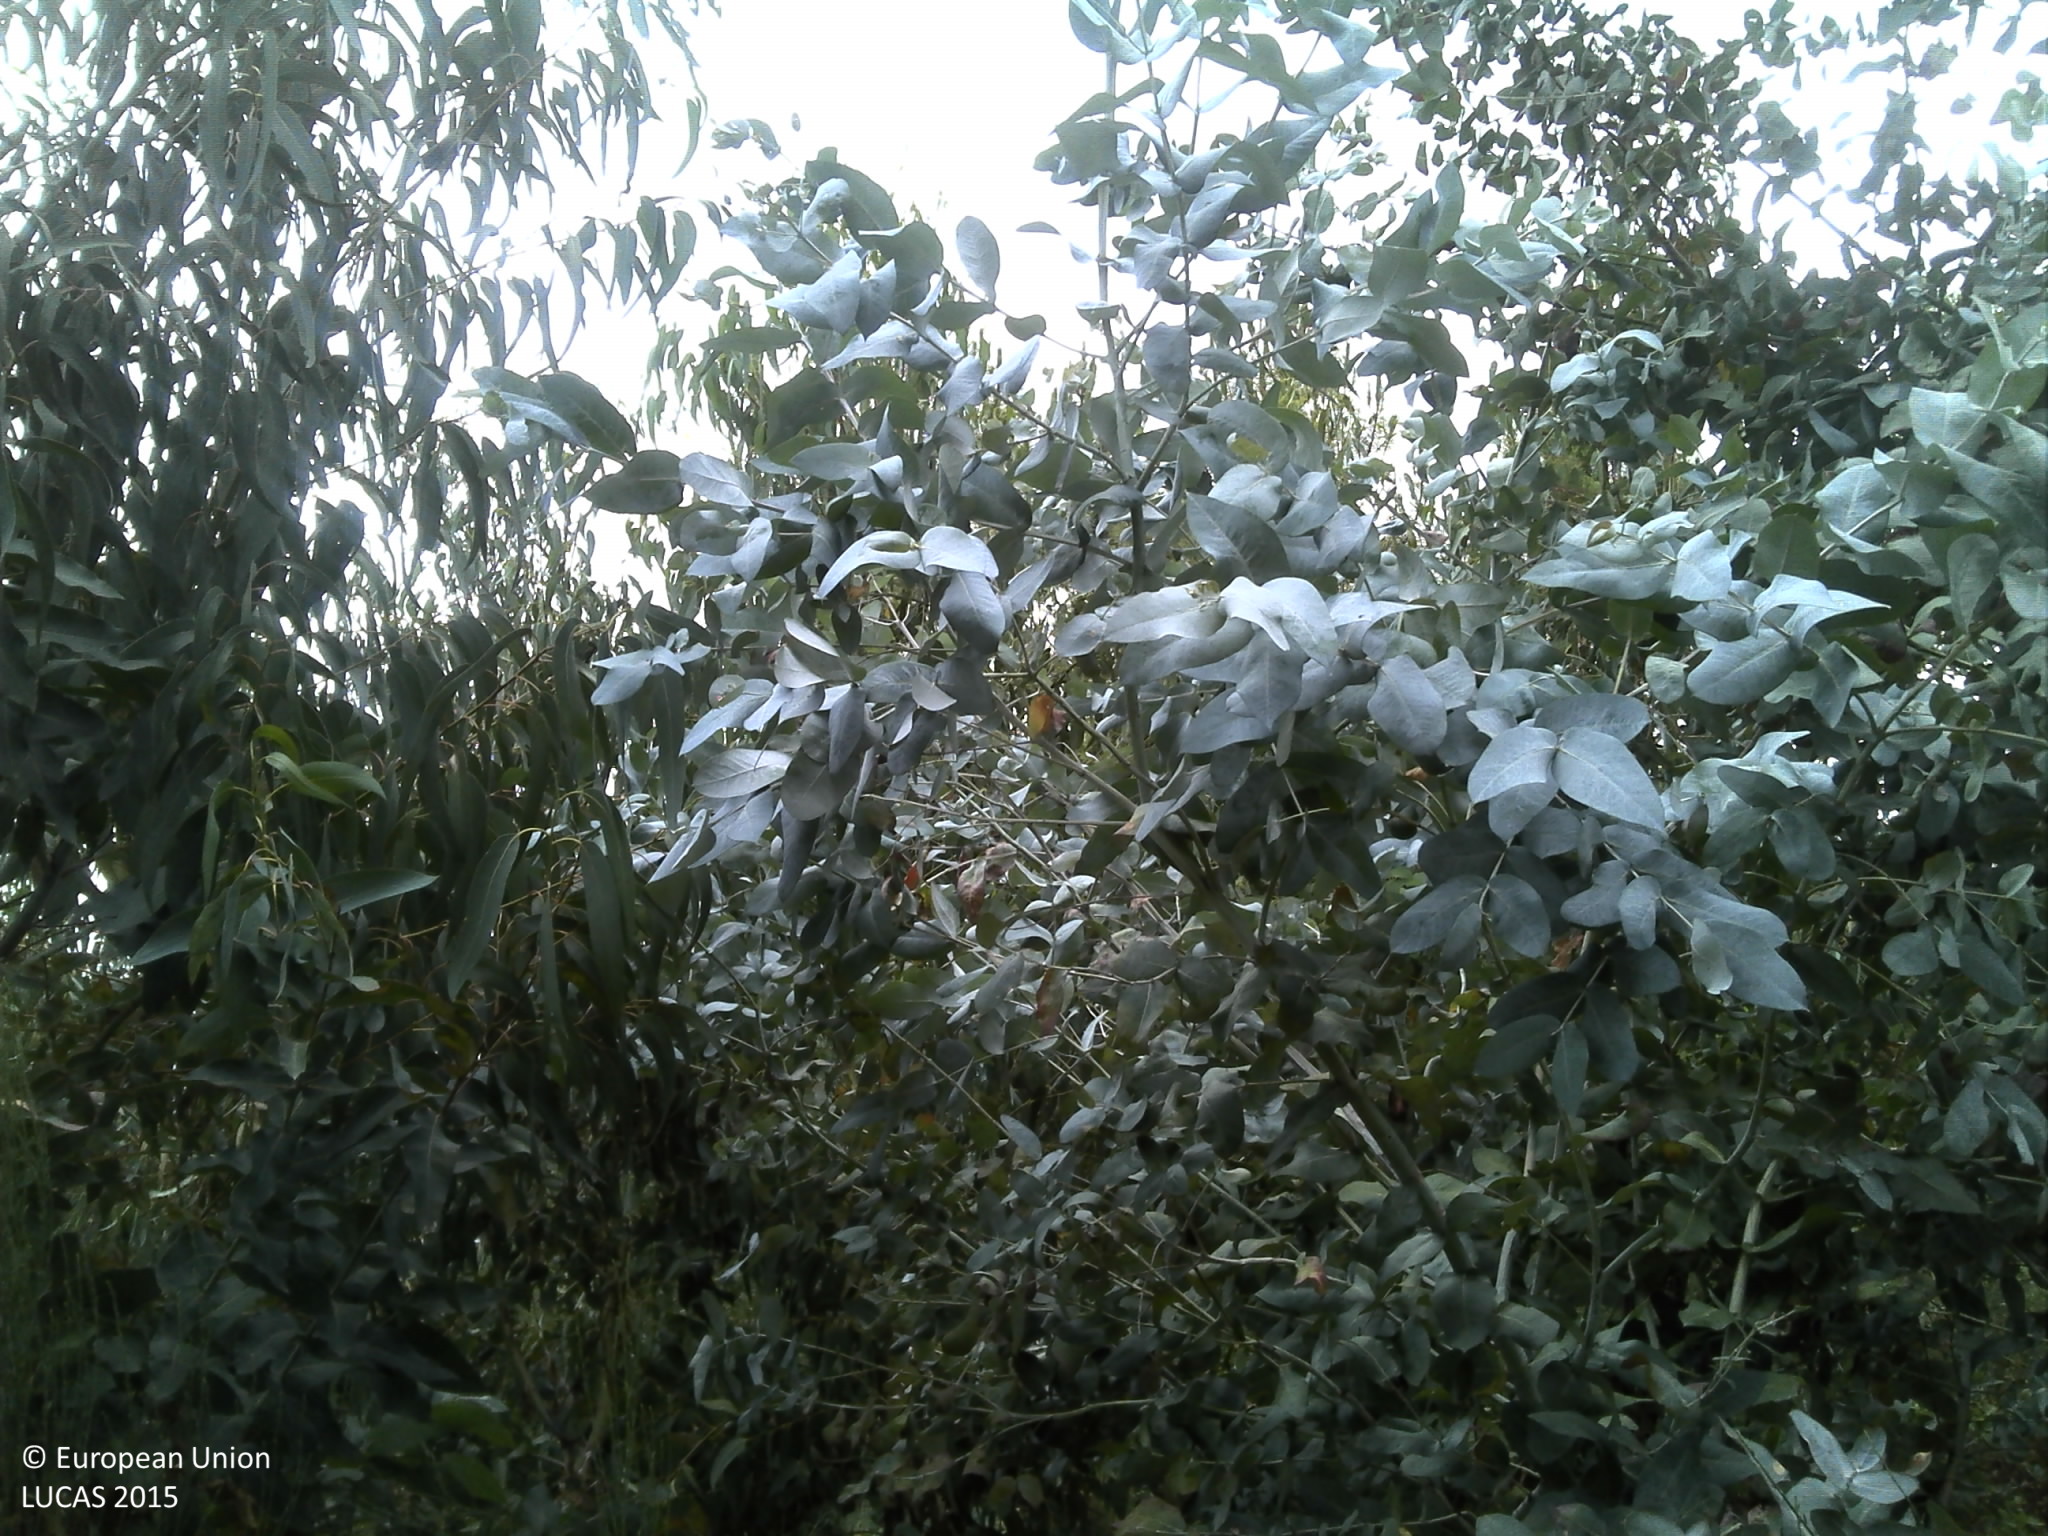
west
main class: Woodland
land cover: Broadleaved woodland
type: exotic forest
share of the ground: 25 - 50 %
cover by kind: broadleaved forest trees 40 %, unconsolidated bare surface 35 %, shrubs 25 %
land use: Forestry
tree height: > 5 m
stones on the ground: 10 - 25 %
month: June
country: PT
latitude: 40.2689
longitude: -7.1860
